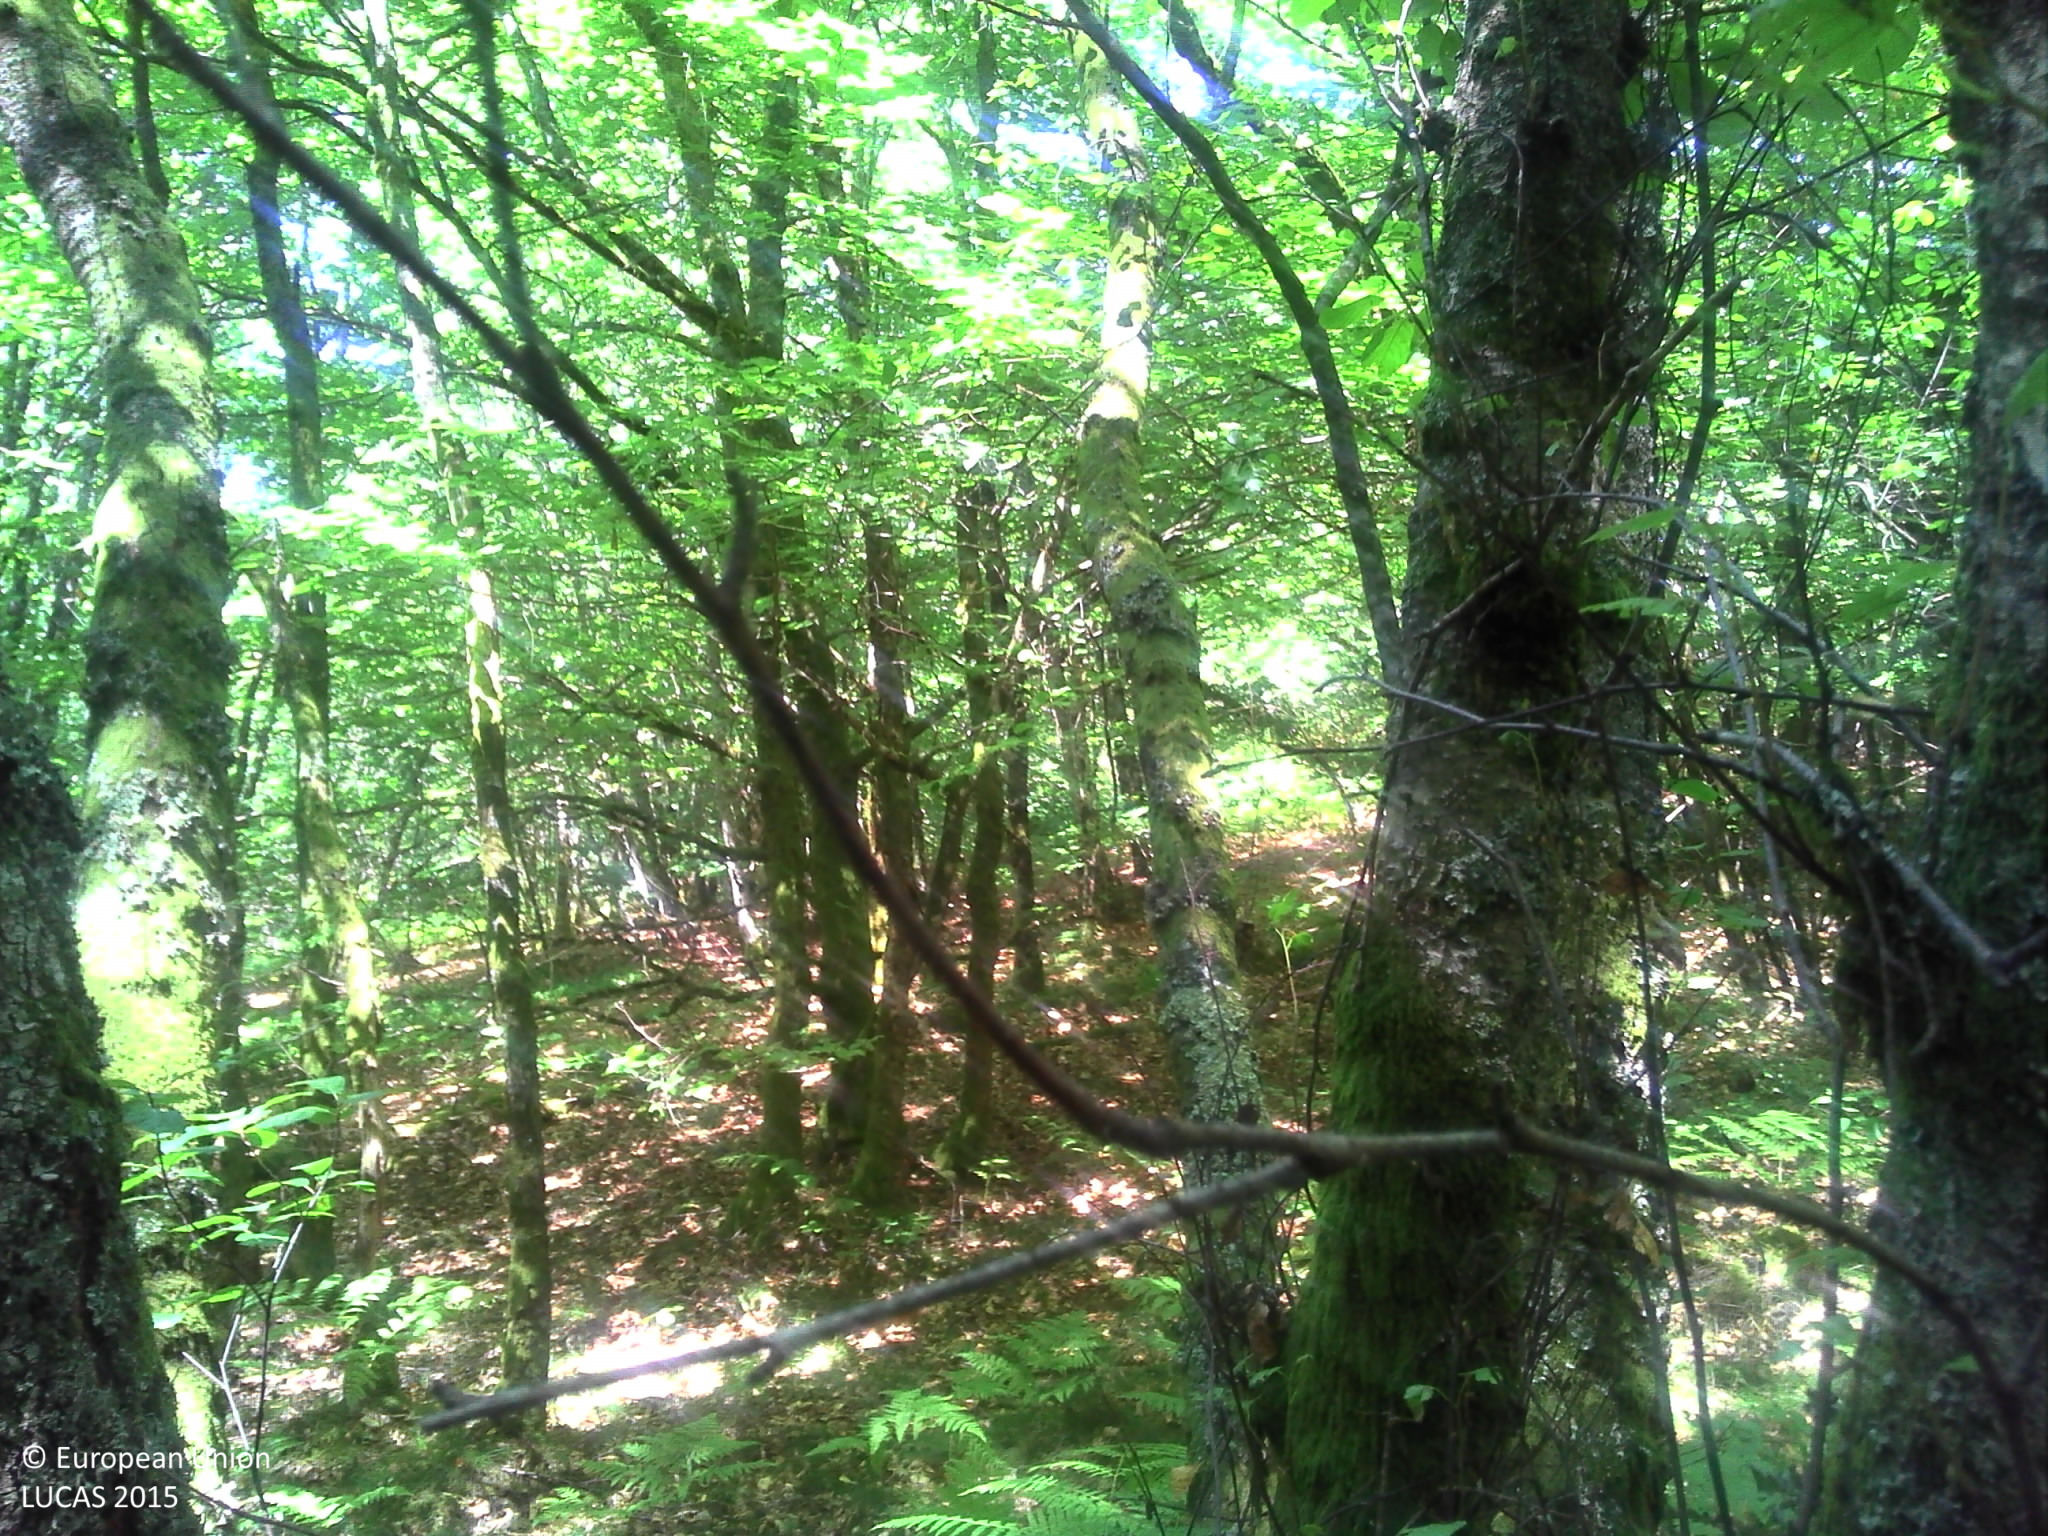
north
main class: Woodland
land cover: Broadleaved woodland
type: acidophilous oak and oak-birch forest
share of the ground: > 75 %
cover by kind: broadleaved forest trees 85 %, lichens and mosses 10 %, herbaceous plants 5 %
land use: Forestry
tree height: > 5 m
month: July
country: FR
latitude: 46.0548
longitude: 1.5775
